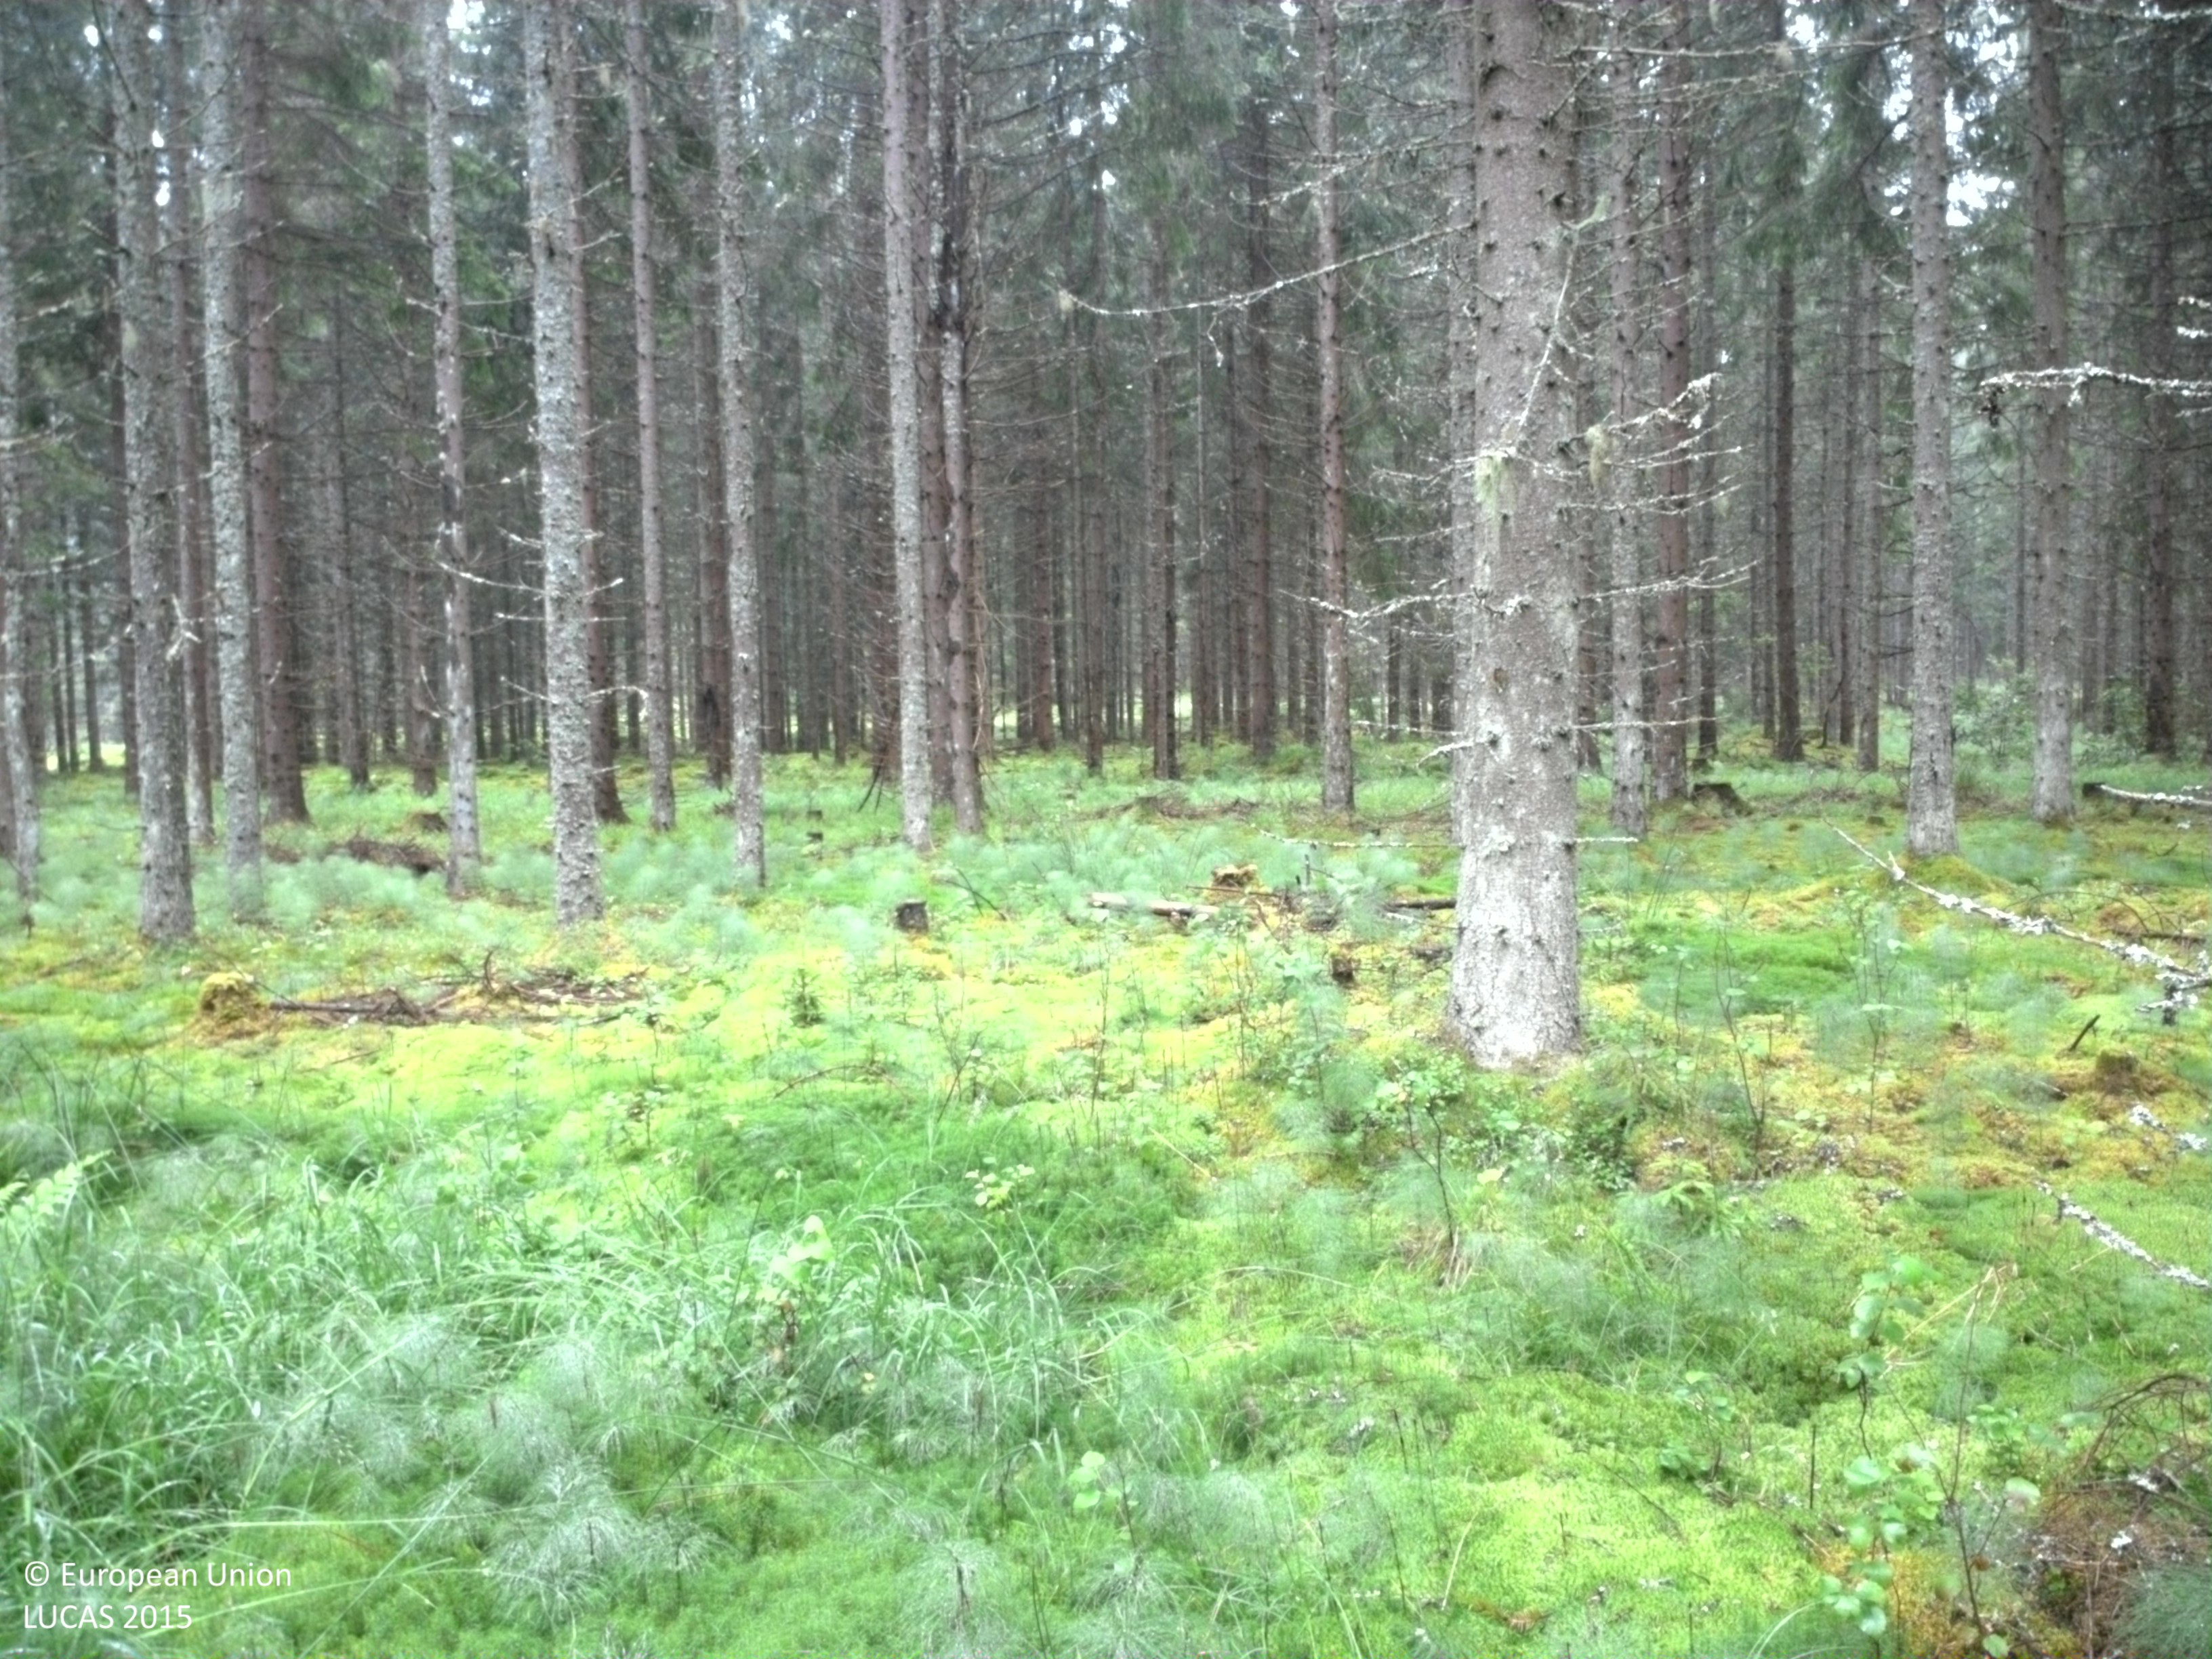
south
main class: Woodland
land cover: Spruce dominated coniferous woodland
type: boreal forest
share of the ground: 50 - 75 %
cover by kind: coniferous forest trees 65 %, shrubs 20 %, lichens and mosses 10 %, broadleaved forest trees 5 %
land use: Forestry
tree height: > 5 m
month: August
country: SE
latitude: 59.4602
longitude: 13.1859
